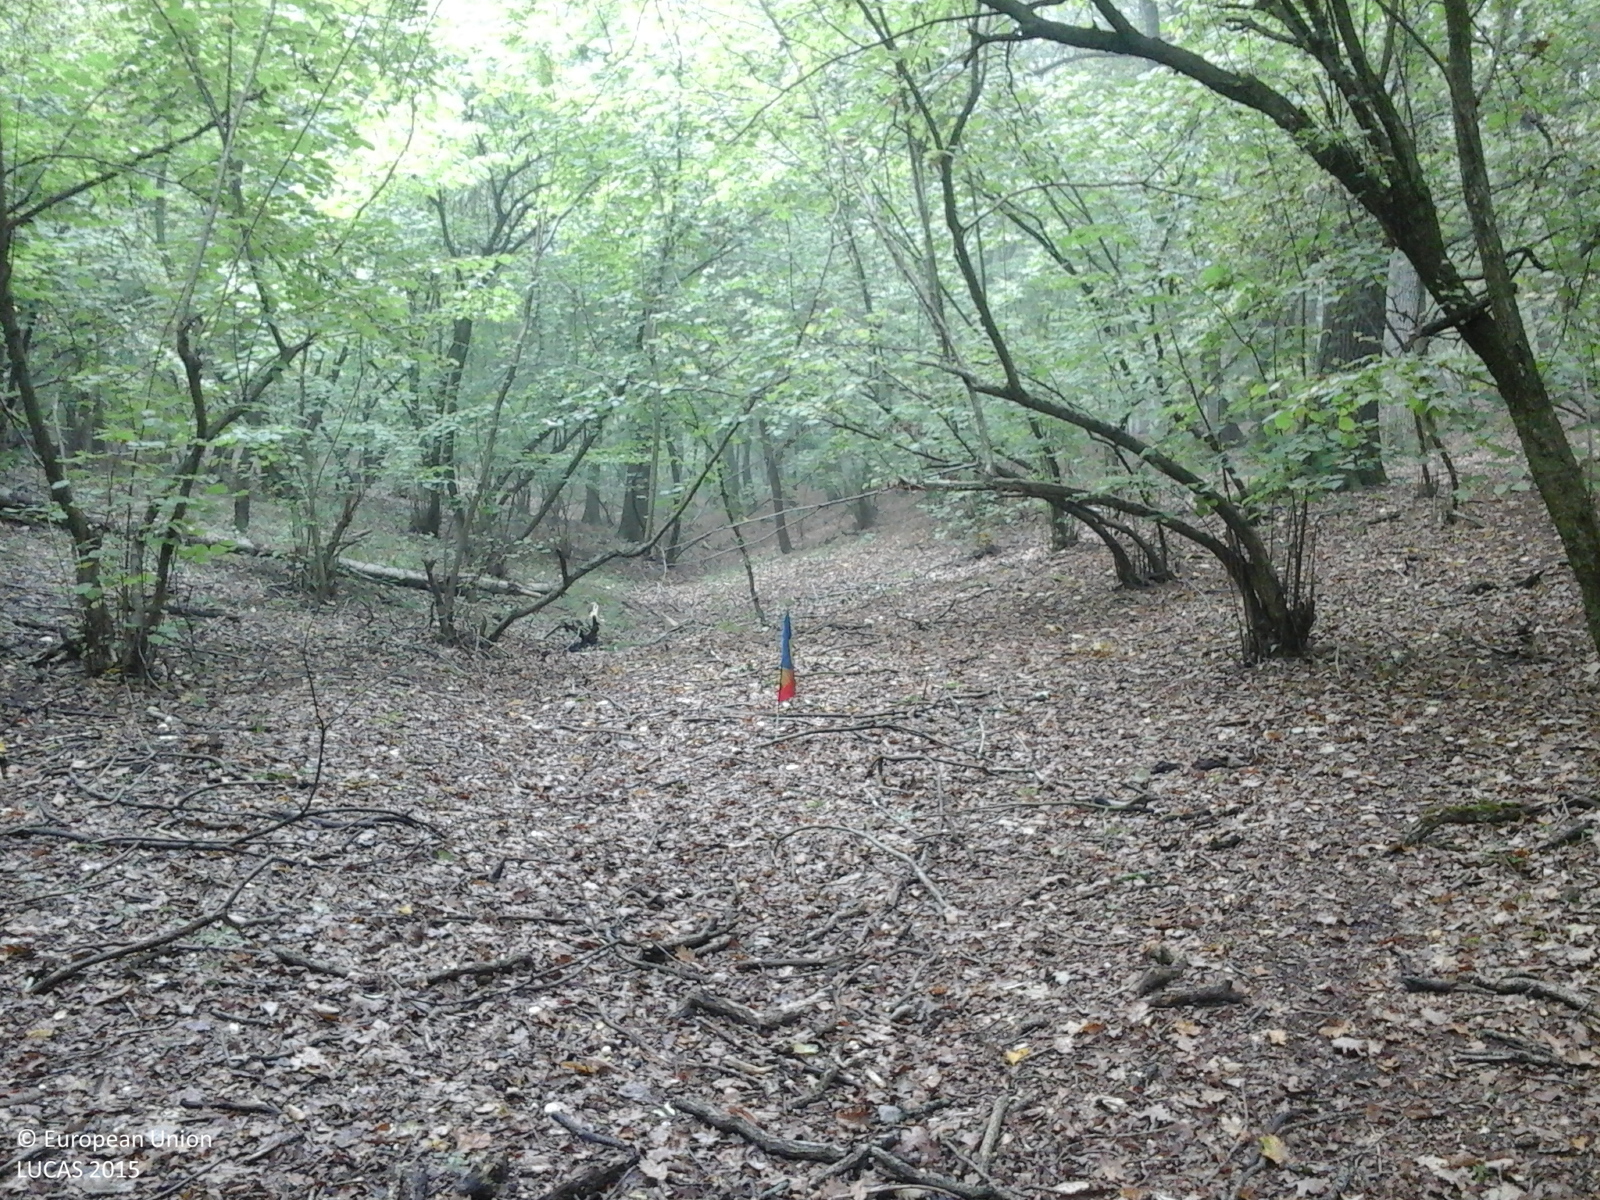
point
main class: Woodland
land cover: Broadleaved woodland
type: mesophytic deciduous forest
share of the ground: > 75 %
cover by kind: broadleaved forest trees 100 %
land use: Forestry
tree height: > 5 m
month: October
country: RO
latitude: 46.3409
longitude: 24.2555
